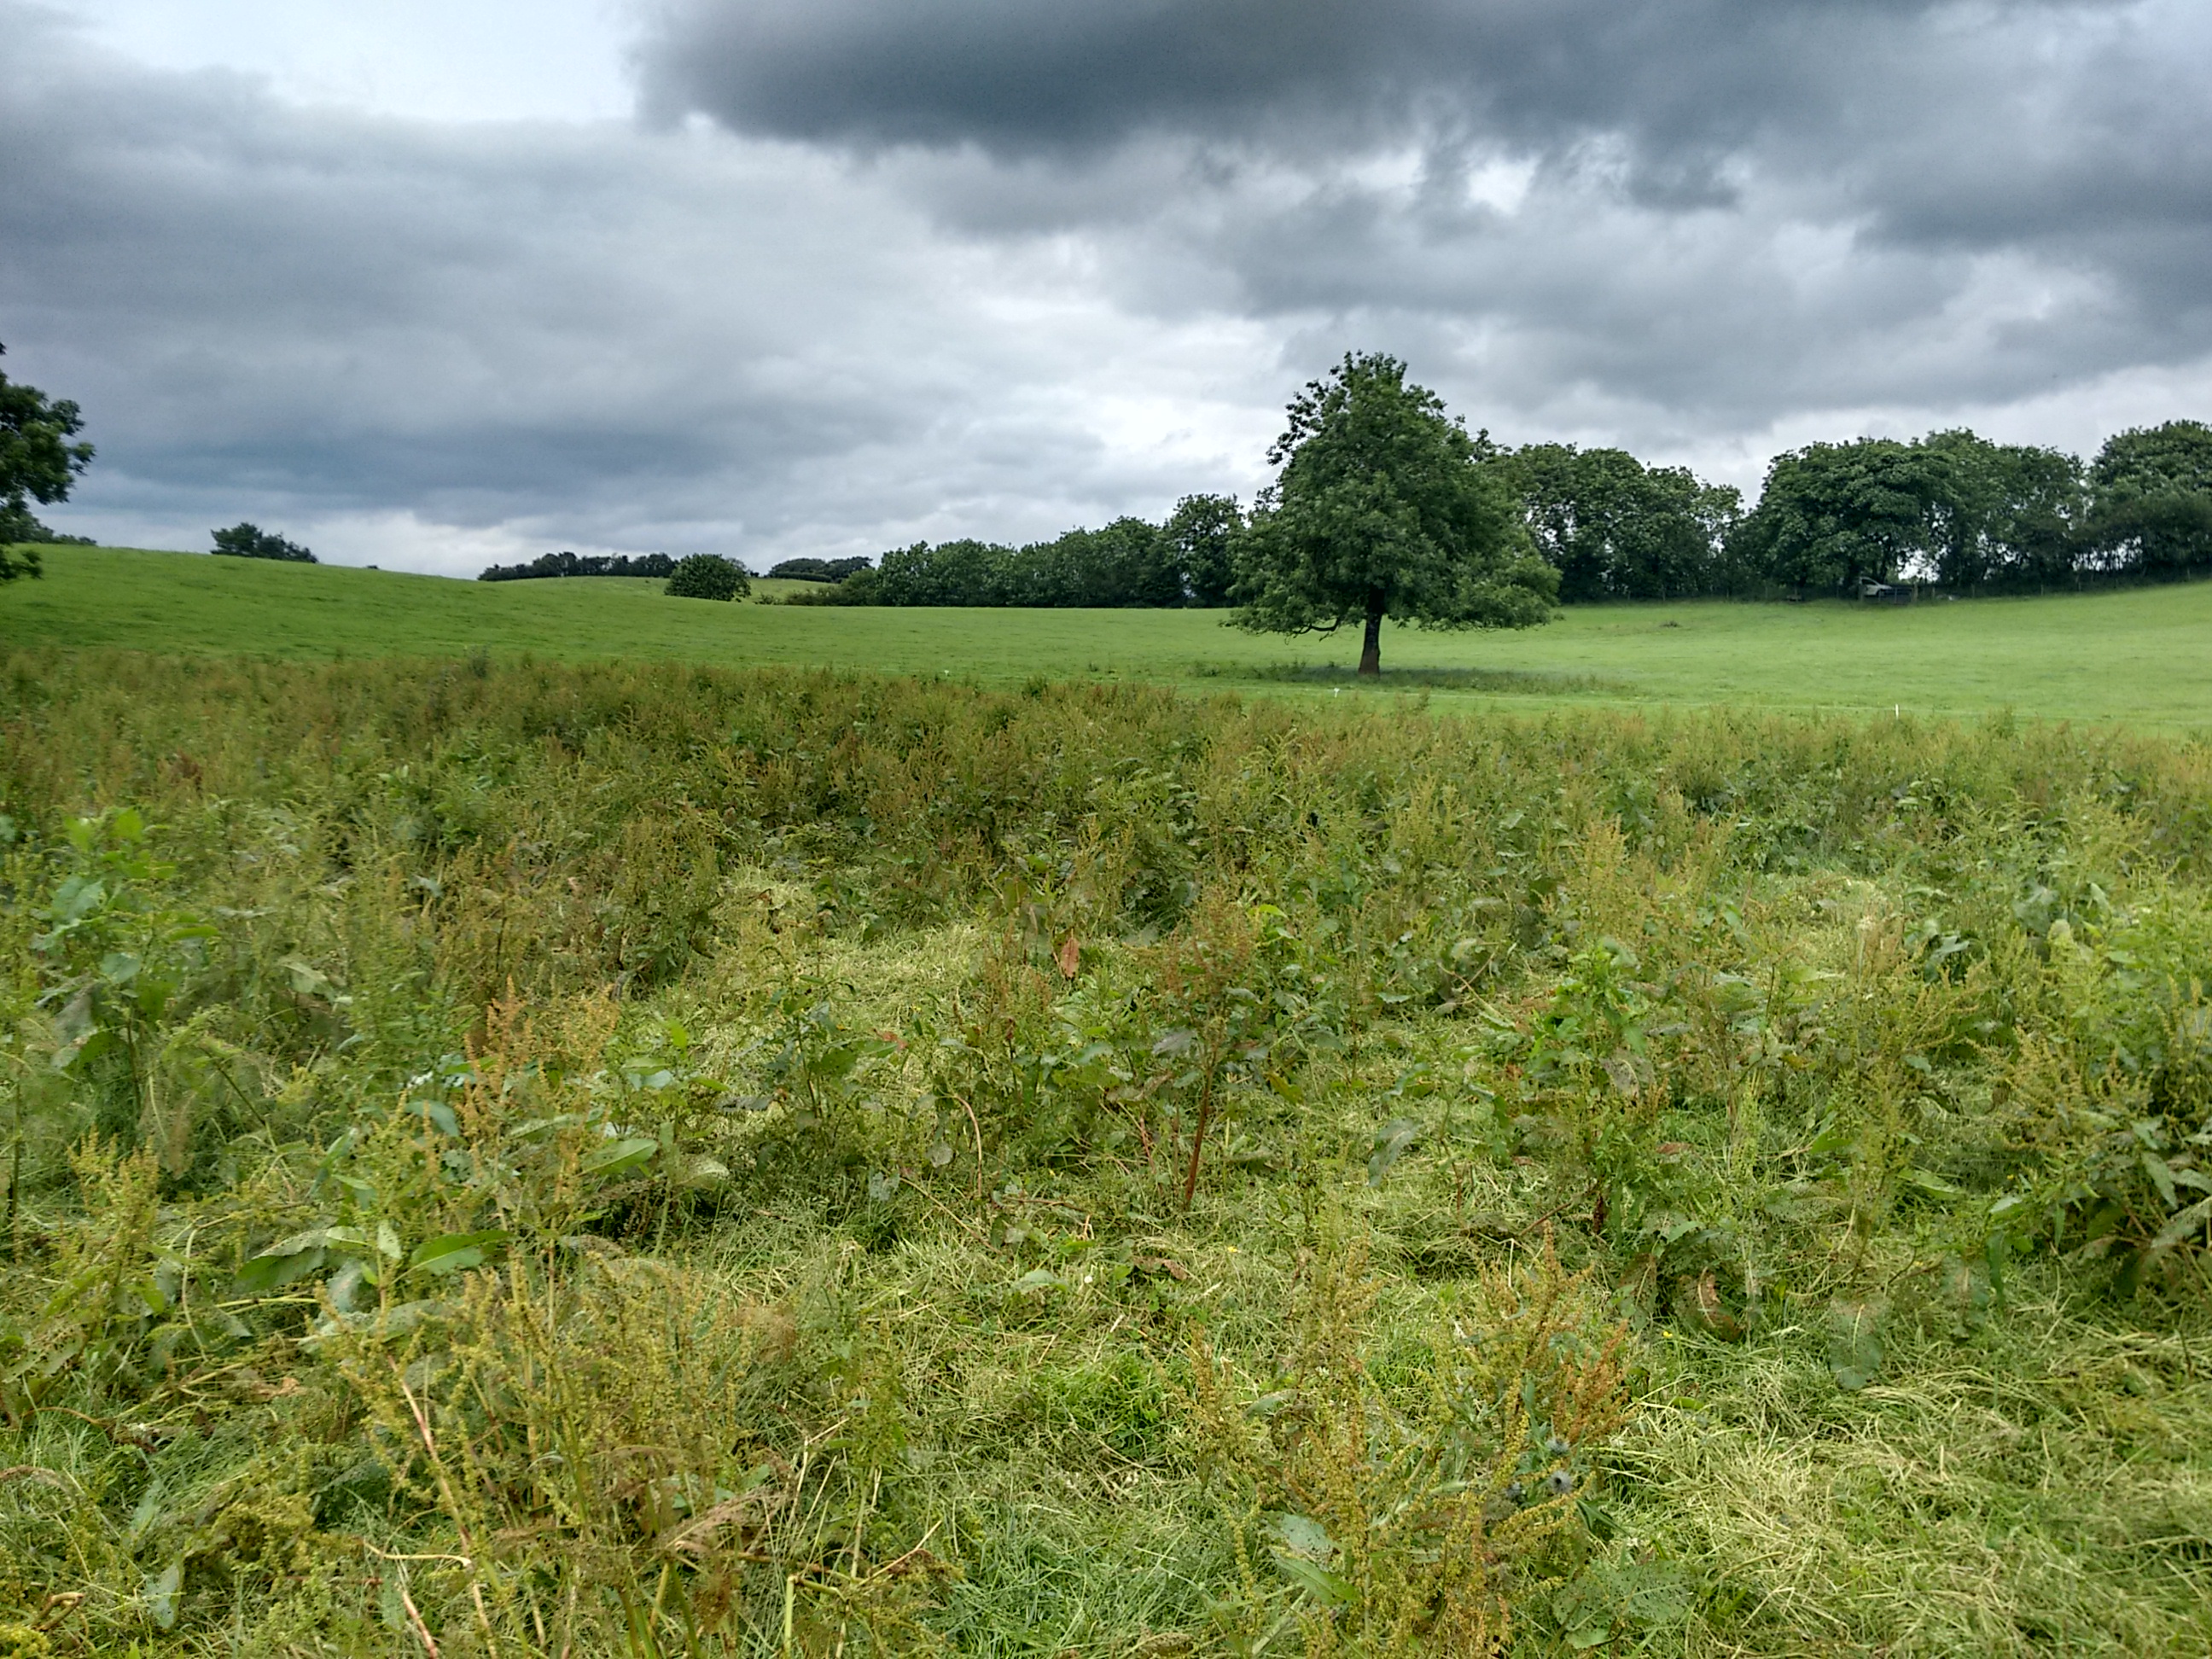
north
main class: Grassland
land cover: Grassland without tree/shrub cover
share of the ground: > 75 %
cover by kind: herbaceous plants 100 %
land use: Agriculture (excluding fallow land and kitchen gardens)
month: July
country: GB
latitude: 54.5736
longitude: -7.1766
